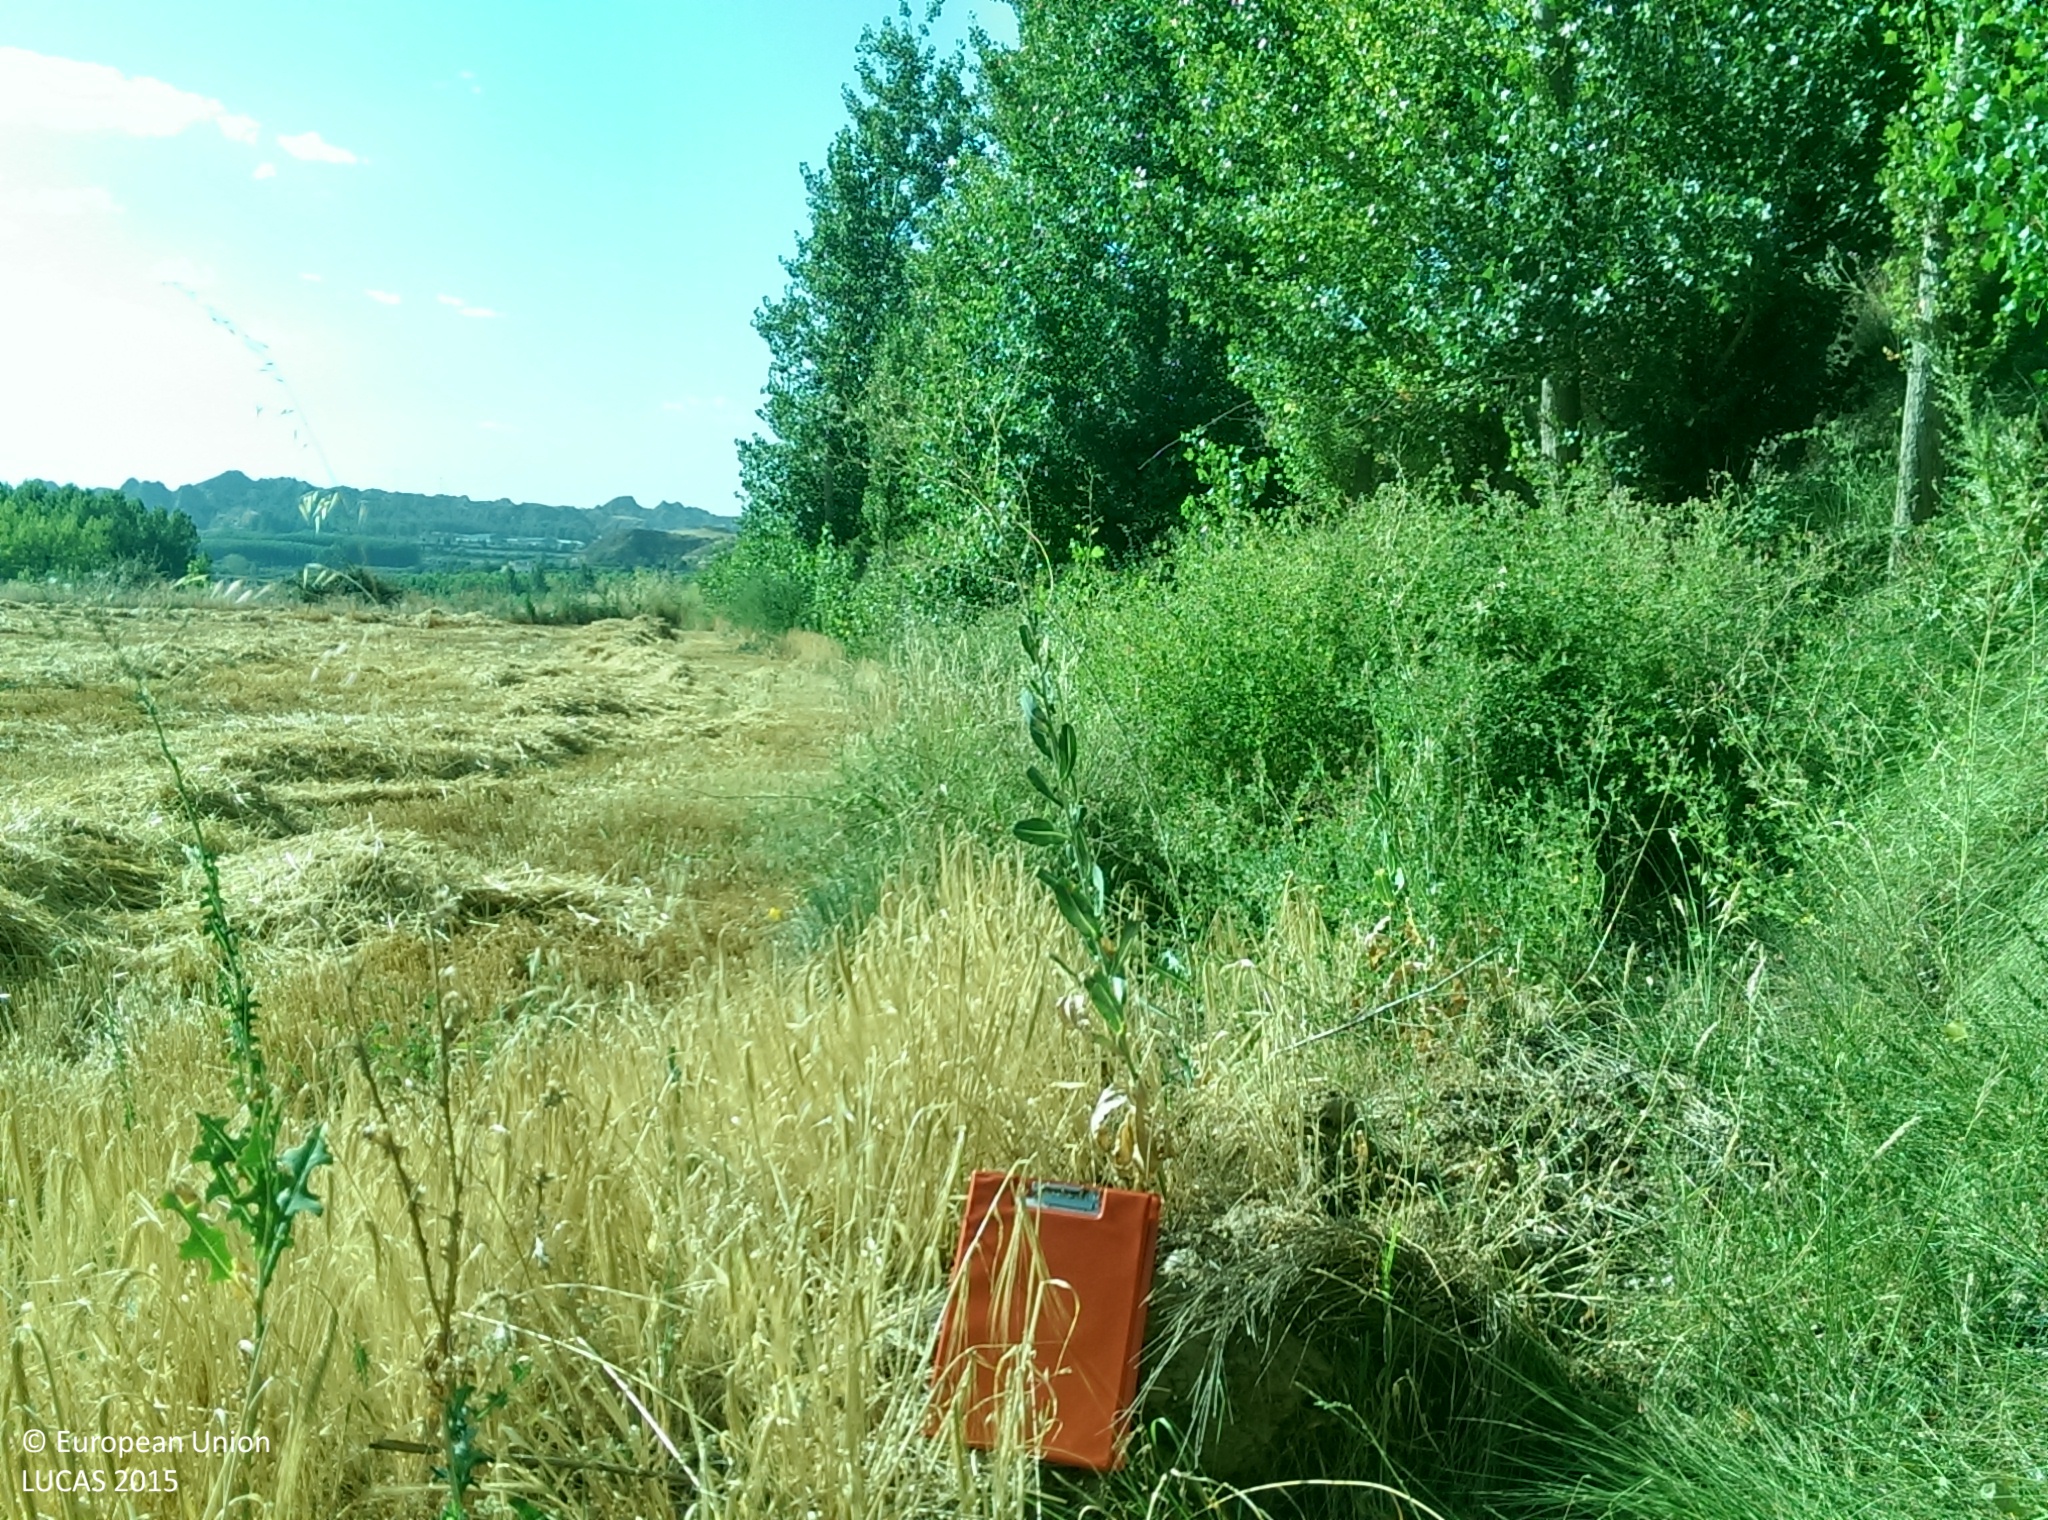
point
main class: Cropland
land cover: Barley
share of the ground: < 10 %
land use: Agriculture (excluding fallow land and kitchen gardens)
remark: Harvested field
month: July
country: ES
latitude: 37.3361
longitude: -3.2052
